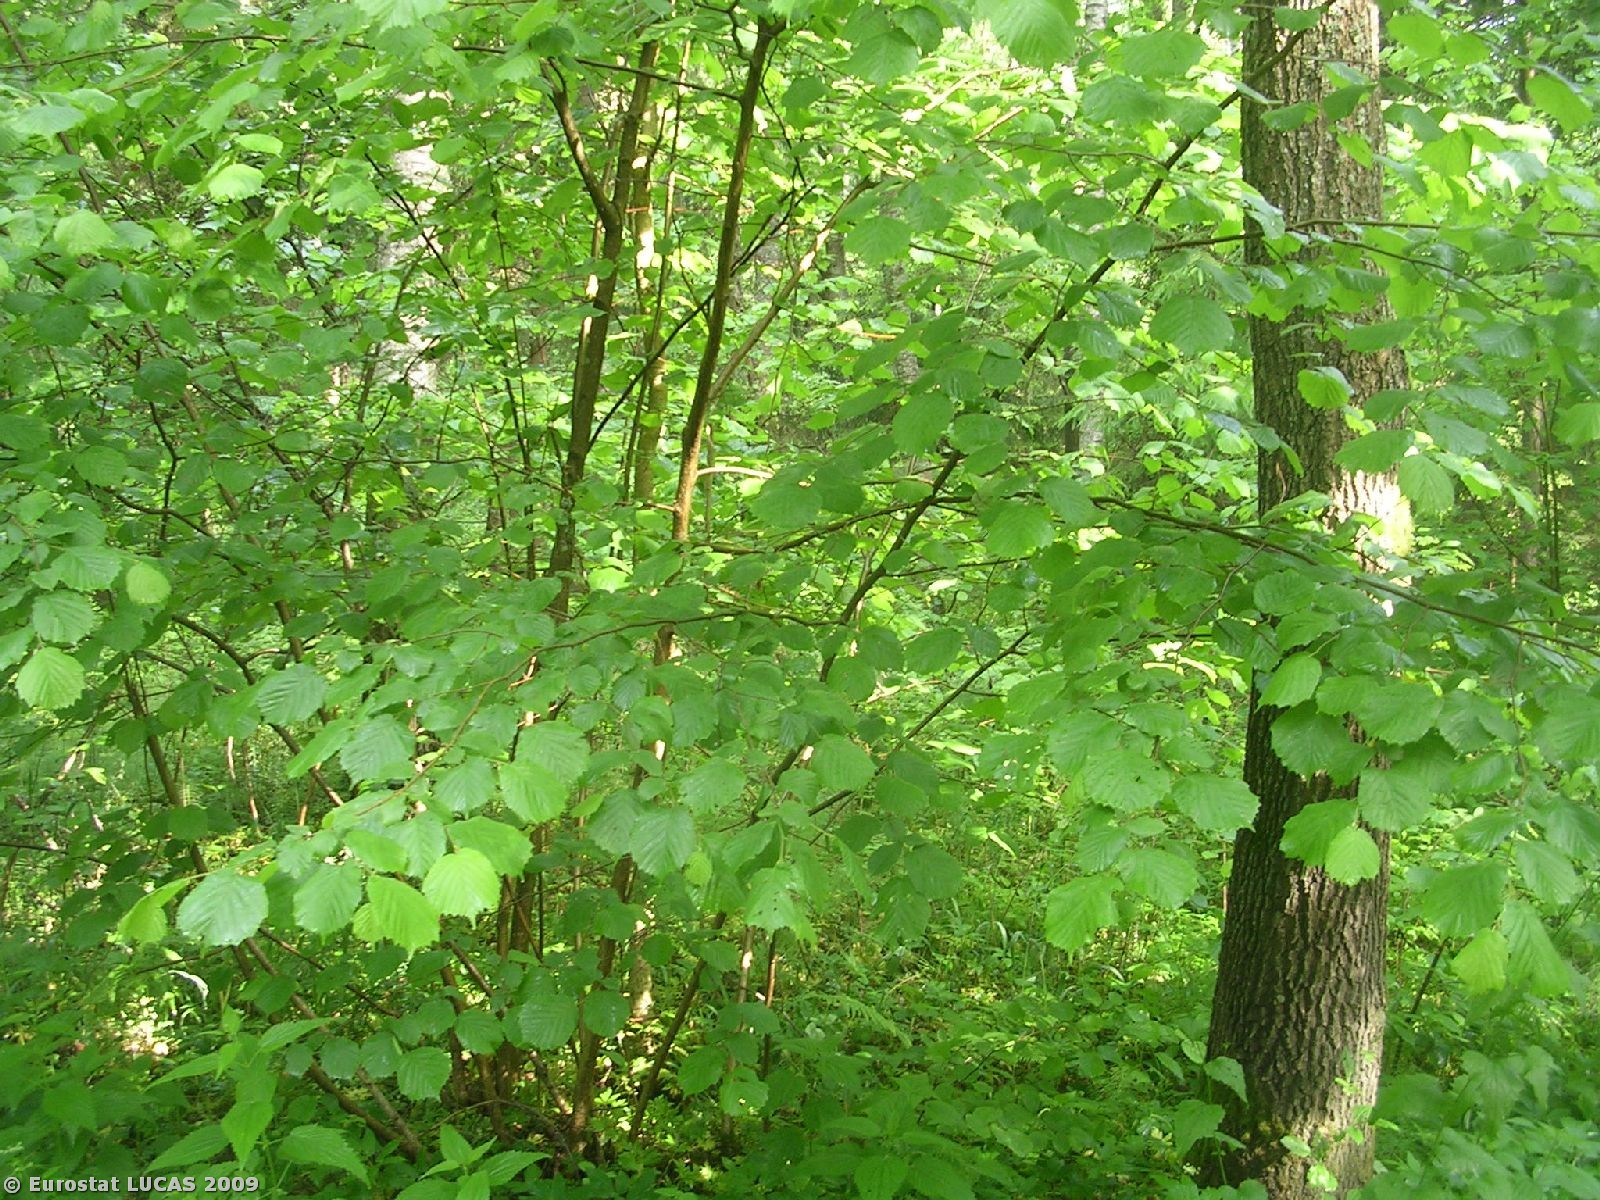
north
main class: Woodland
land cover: Mixed woodland
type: hemiboreal forest and nemoral coniferous forest and mixed broadleaved-coniferous forest
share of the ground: 50 - 75 %
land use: Forestry
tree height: > 5 m
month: June
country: PL
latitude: 53.4289
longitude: 23.3092
